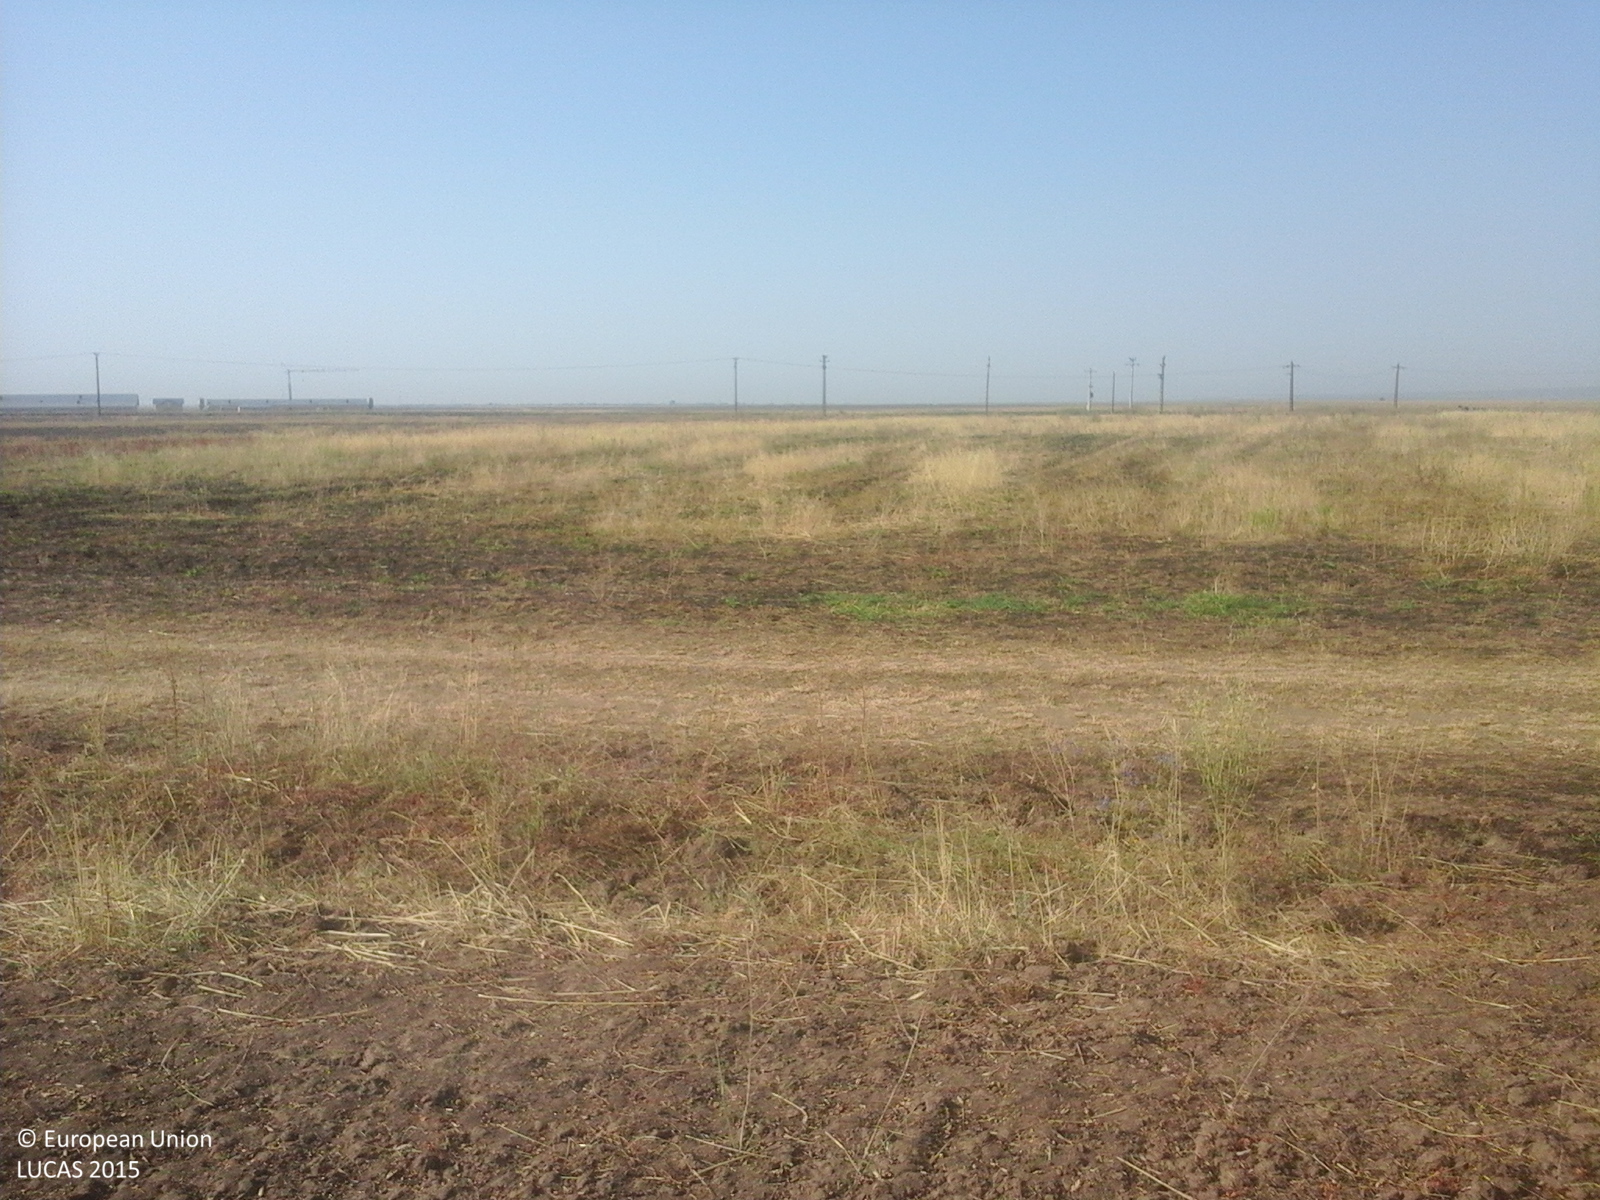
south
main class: Cropland
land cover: Common wheat
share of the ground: < 10 %
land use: Agriculture (excluding fallow land and kitchen gardens)
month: August
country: RO
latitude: 44.2224
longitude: 22.9991
